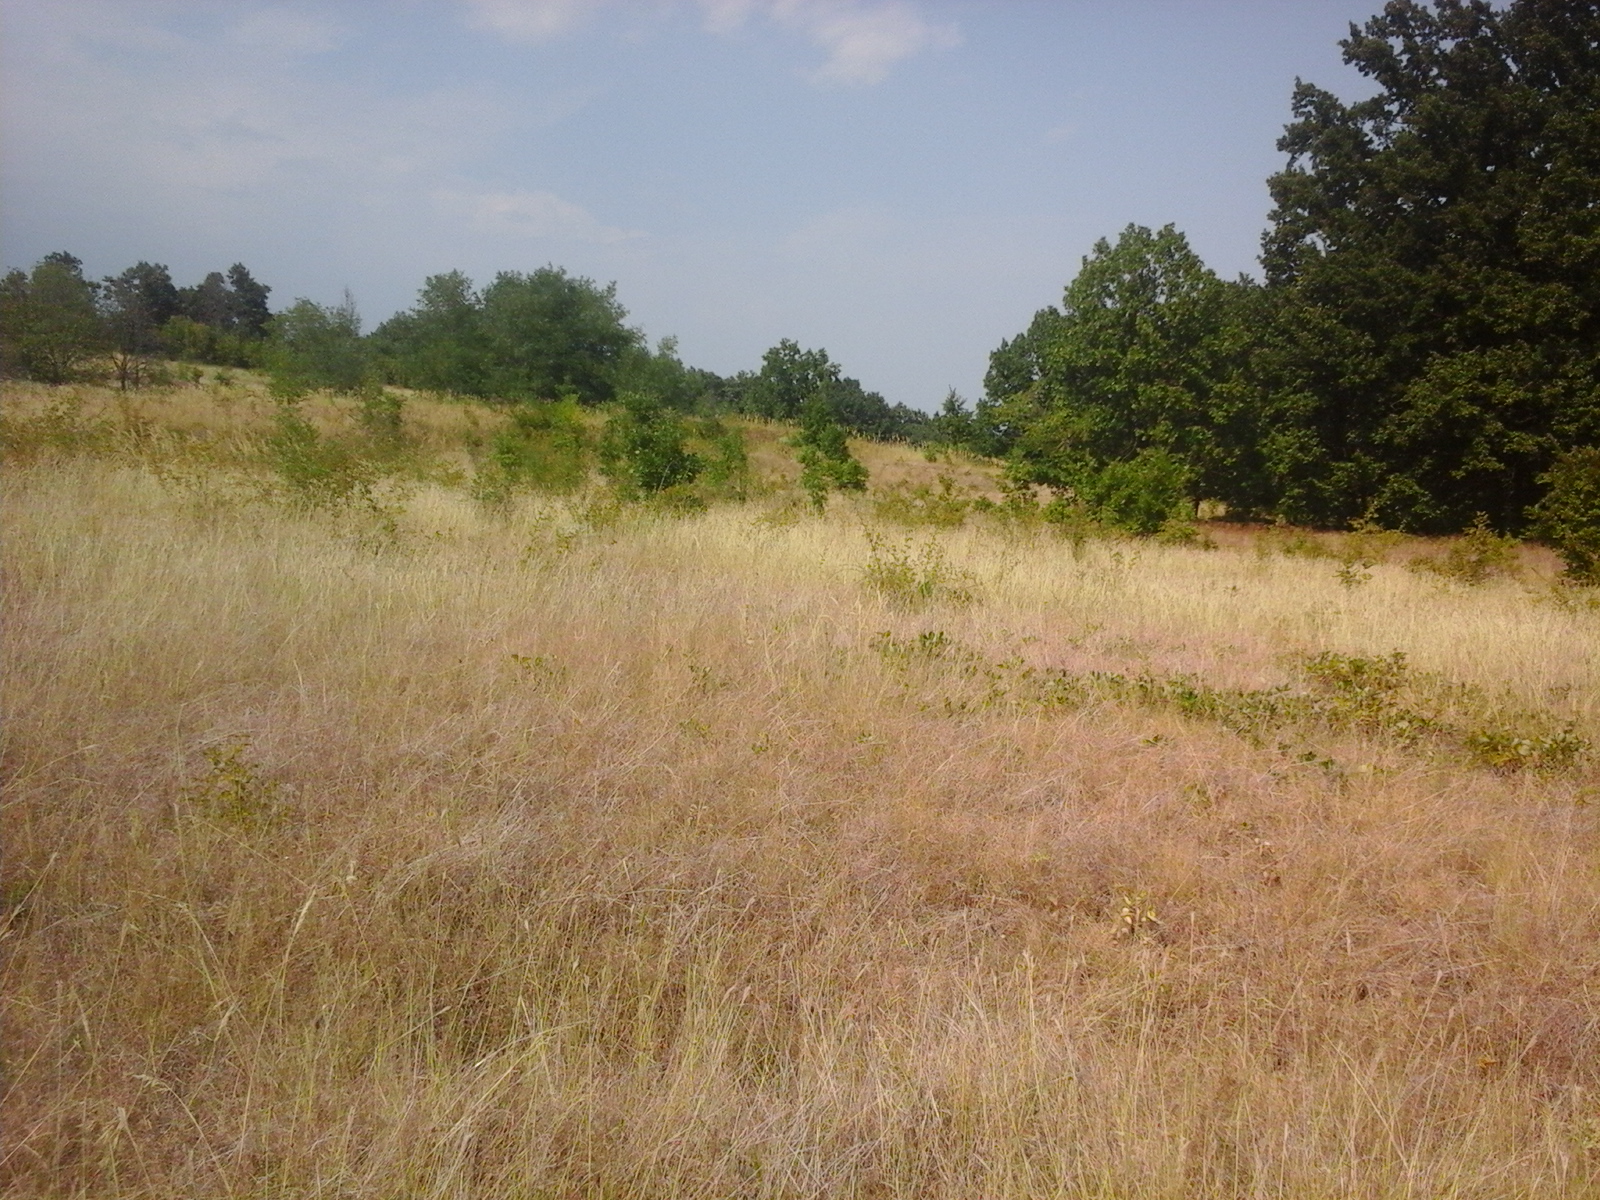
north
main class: Grassland
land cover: Grassland with sparse tree/shrub cover
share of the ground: > 75 %
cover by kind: herbaceous plants 85 %, shrubs 10 %, broadleaved forest trees 5 %
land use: Agriculture (excluding fallow land and kitchen gardens)
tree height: < 5 m
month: August
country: RO
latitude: 44.4962
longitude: 22.7053
